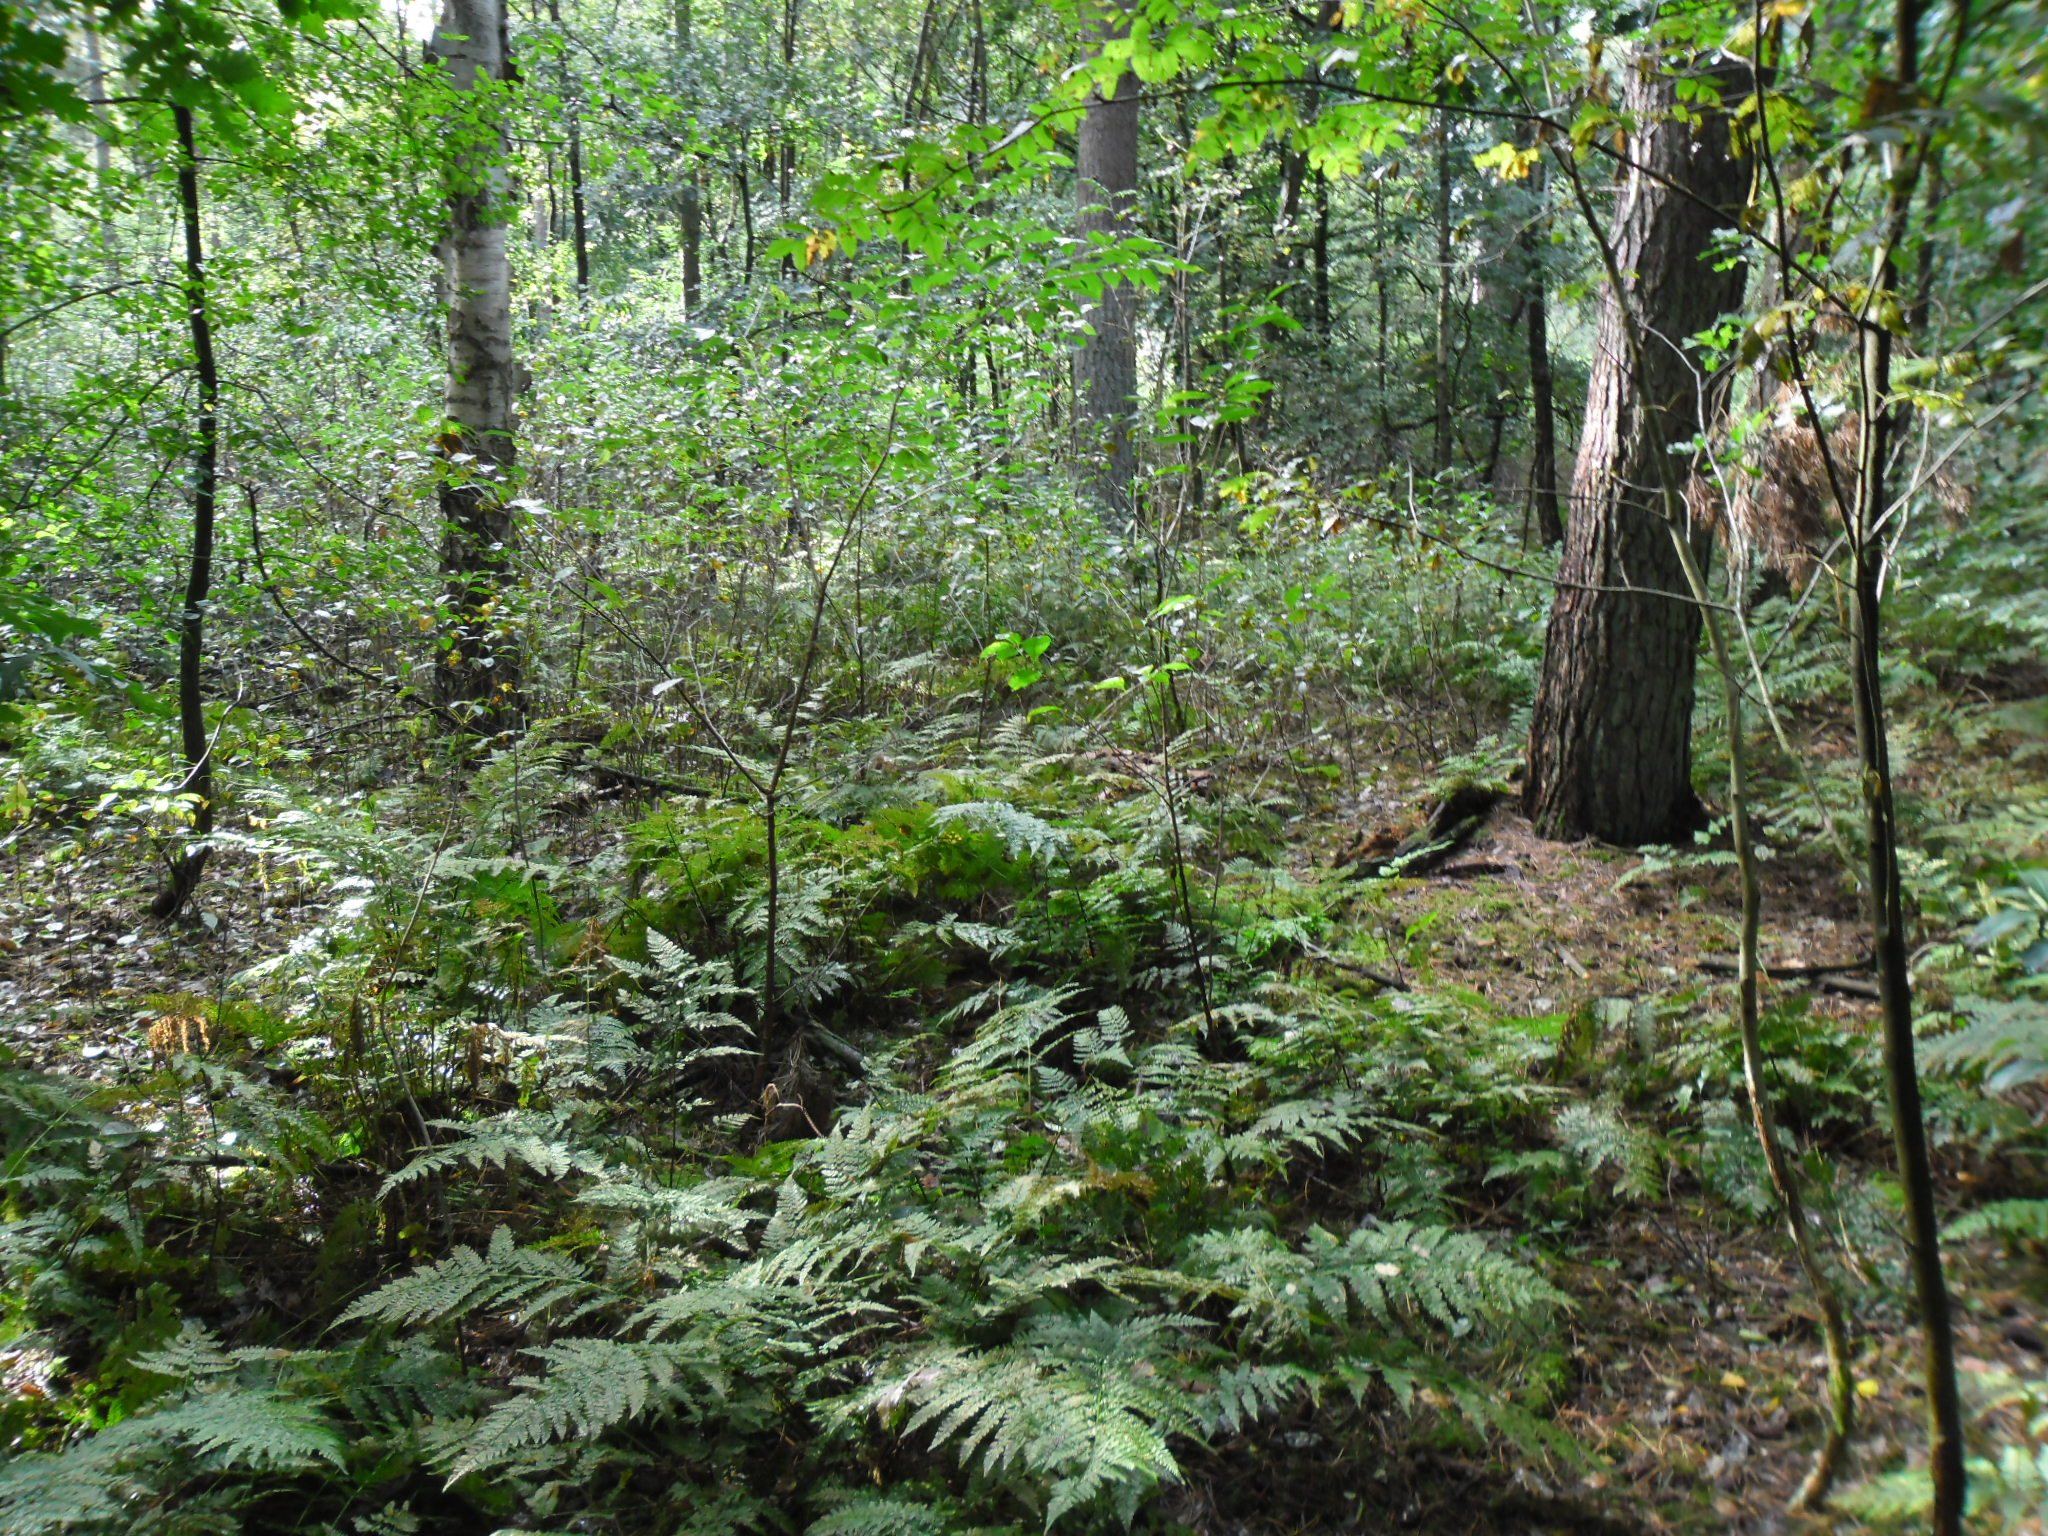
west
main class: Woodland
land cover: Other mixed woodland
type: hemiboreal forest and nemoral coniferous forest and mixed broadleaved-coniferous forest
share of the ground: > 75 %
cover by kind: coniferous forest trees 50 %, broadleaved forest trees 50 %
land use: Forestry
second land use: Amenities, museums, leisure
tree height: > 5 m
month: September
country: NL
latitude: 52.0220
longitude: 5.4952
